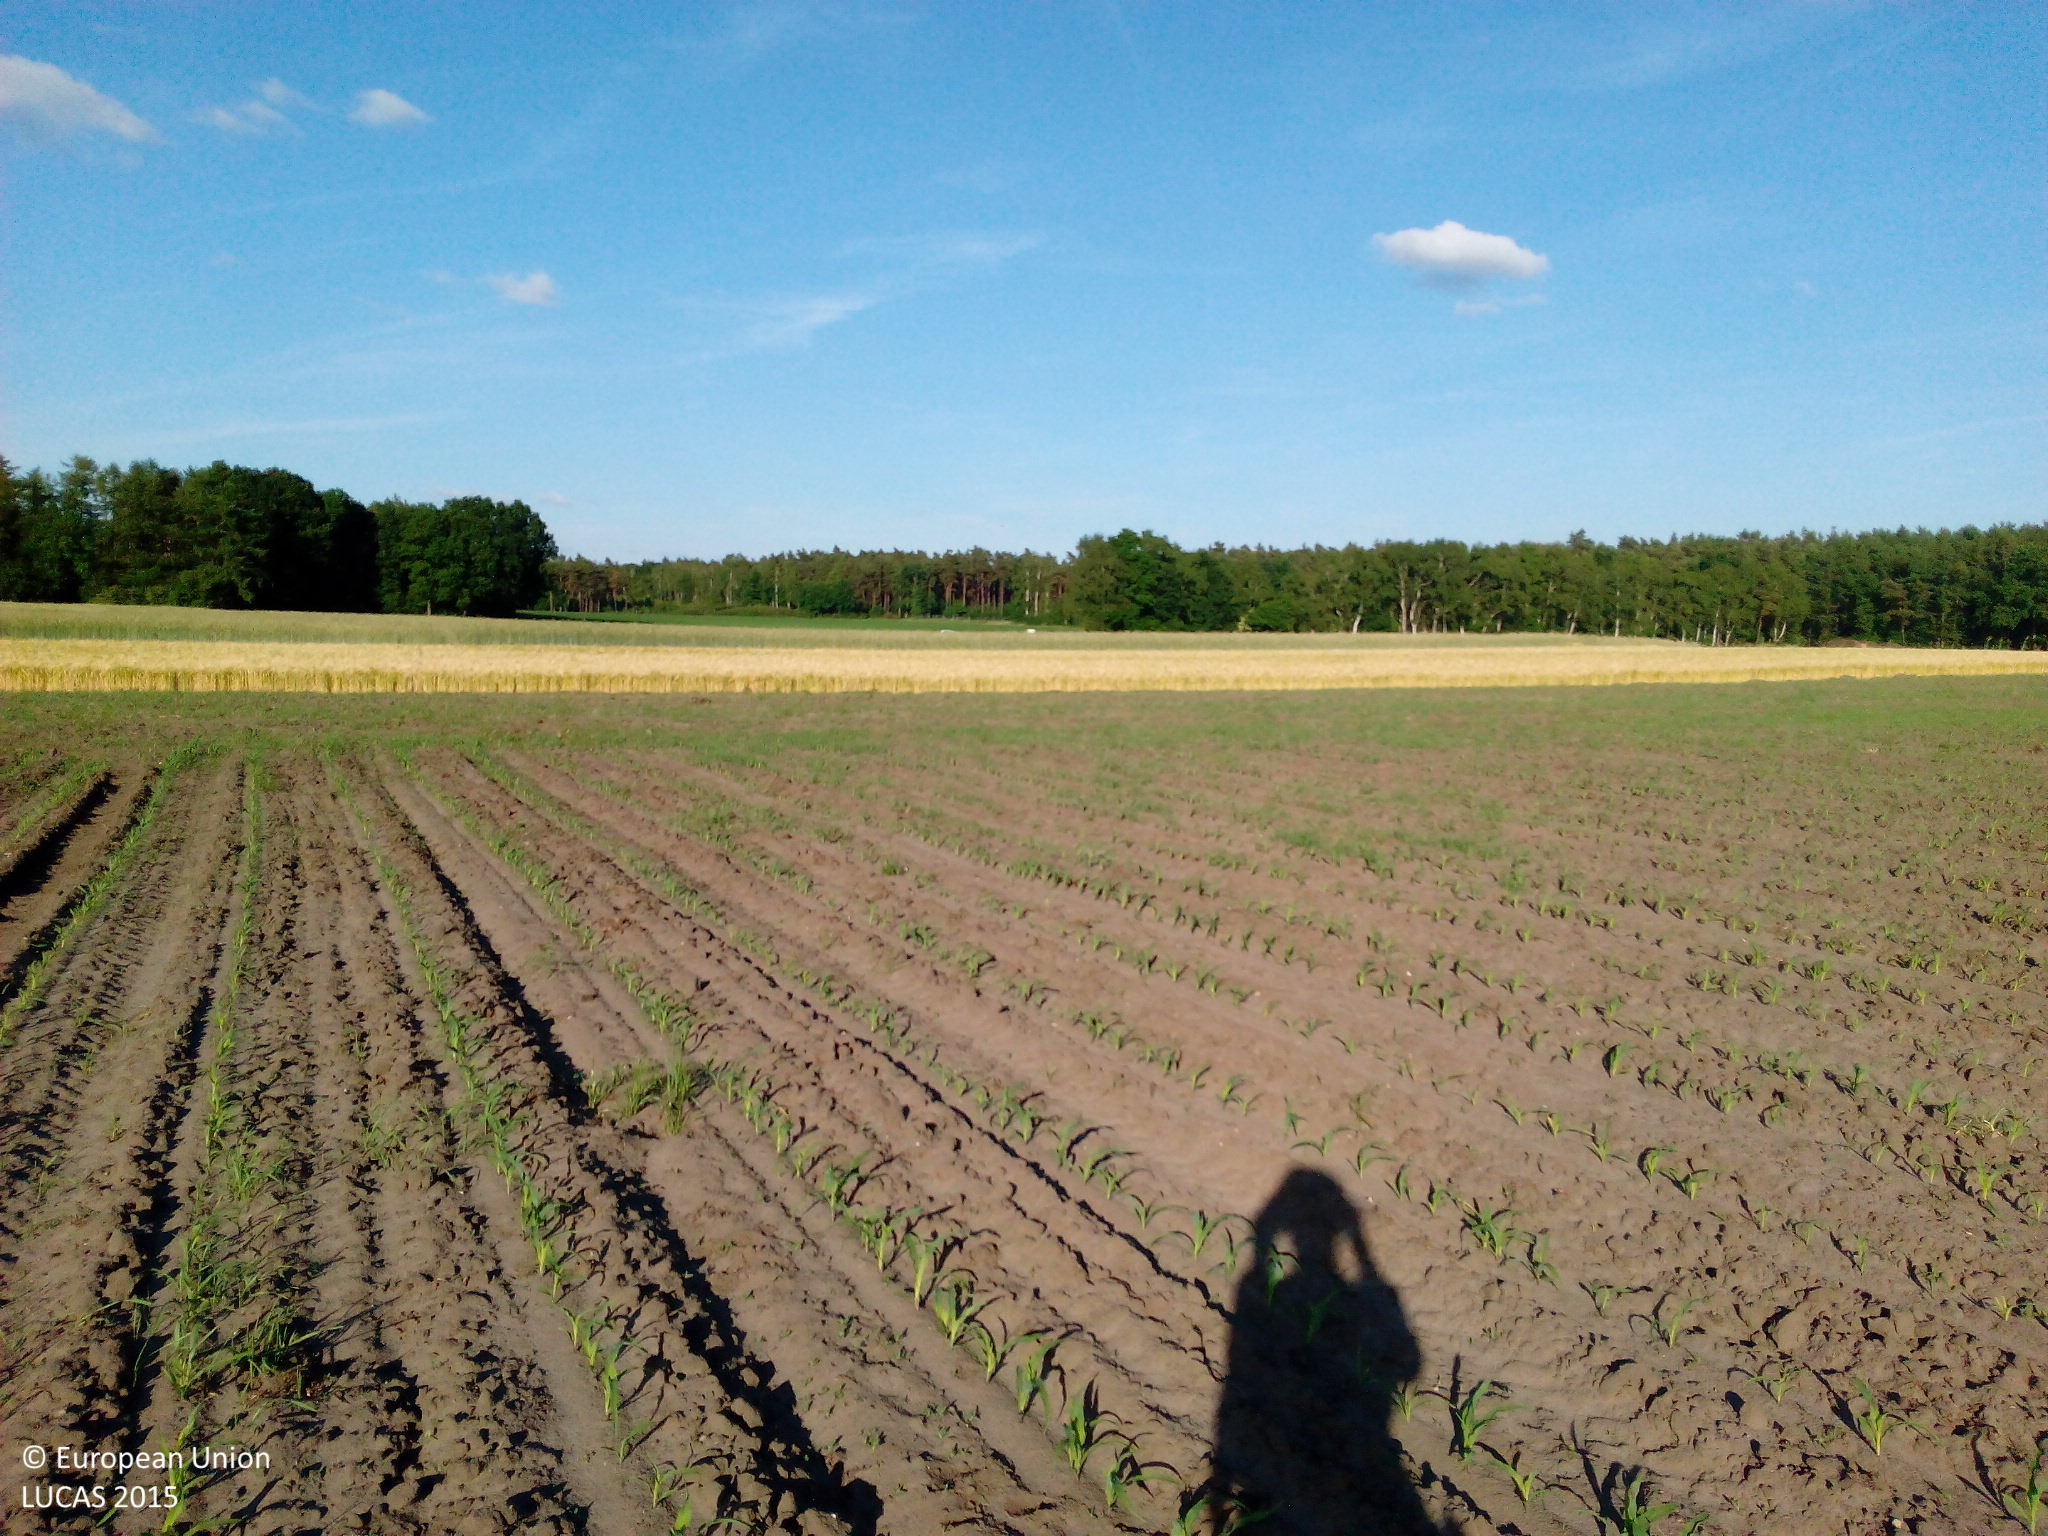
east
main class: Cropland
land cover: Maize
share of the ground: < 10 %
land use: Agriculture (excluding fallow land and kitchen gardens)
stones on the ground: < 10 %
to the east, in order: Maize; Rye; Grass margins; Tracks; Grass margins; Maize
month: June
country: DE
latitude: 52.5114
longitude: 7.4218
